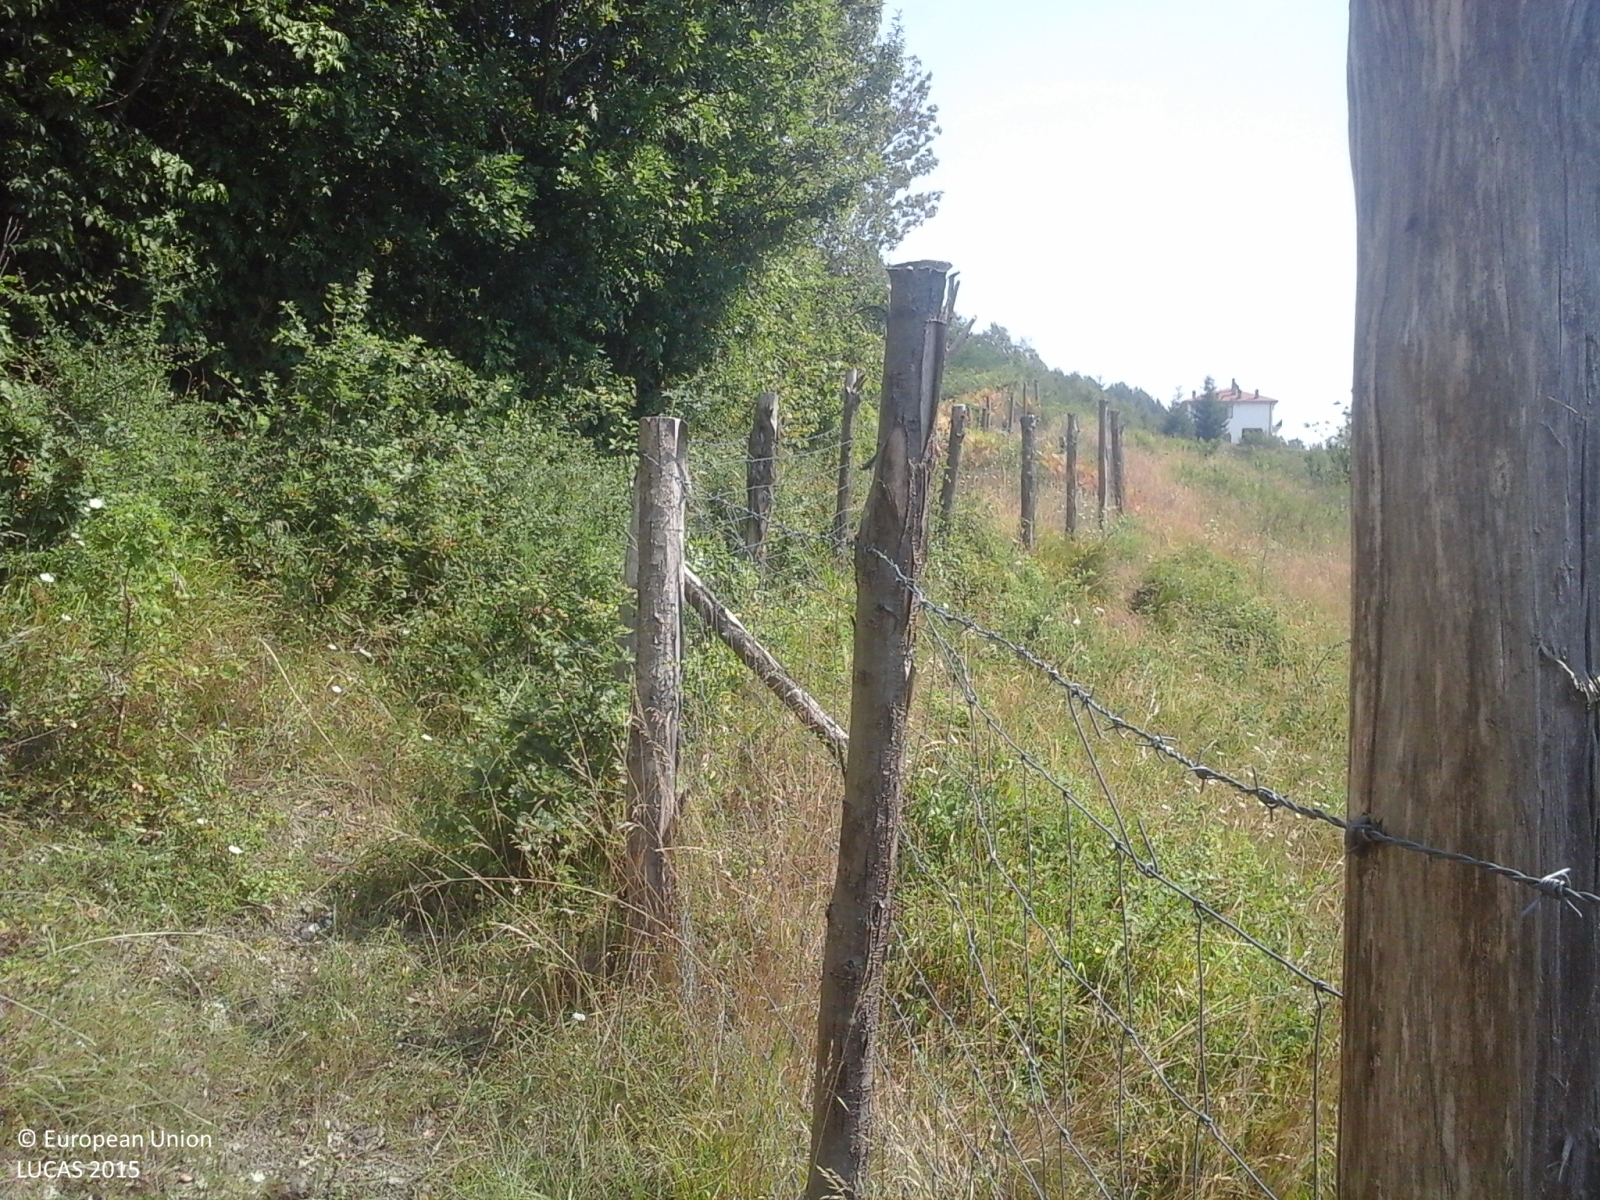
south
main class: Grassland
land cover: Grassland without tree/shrub cover
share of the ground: > 75 %
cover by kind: herbaceous plants 95 %, shrubs 5 %
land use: Semi-natural and natural areas not in use
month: August
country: IT
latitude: 44.3498
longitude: 9.6120
